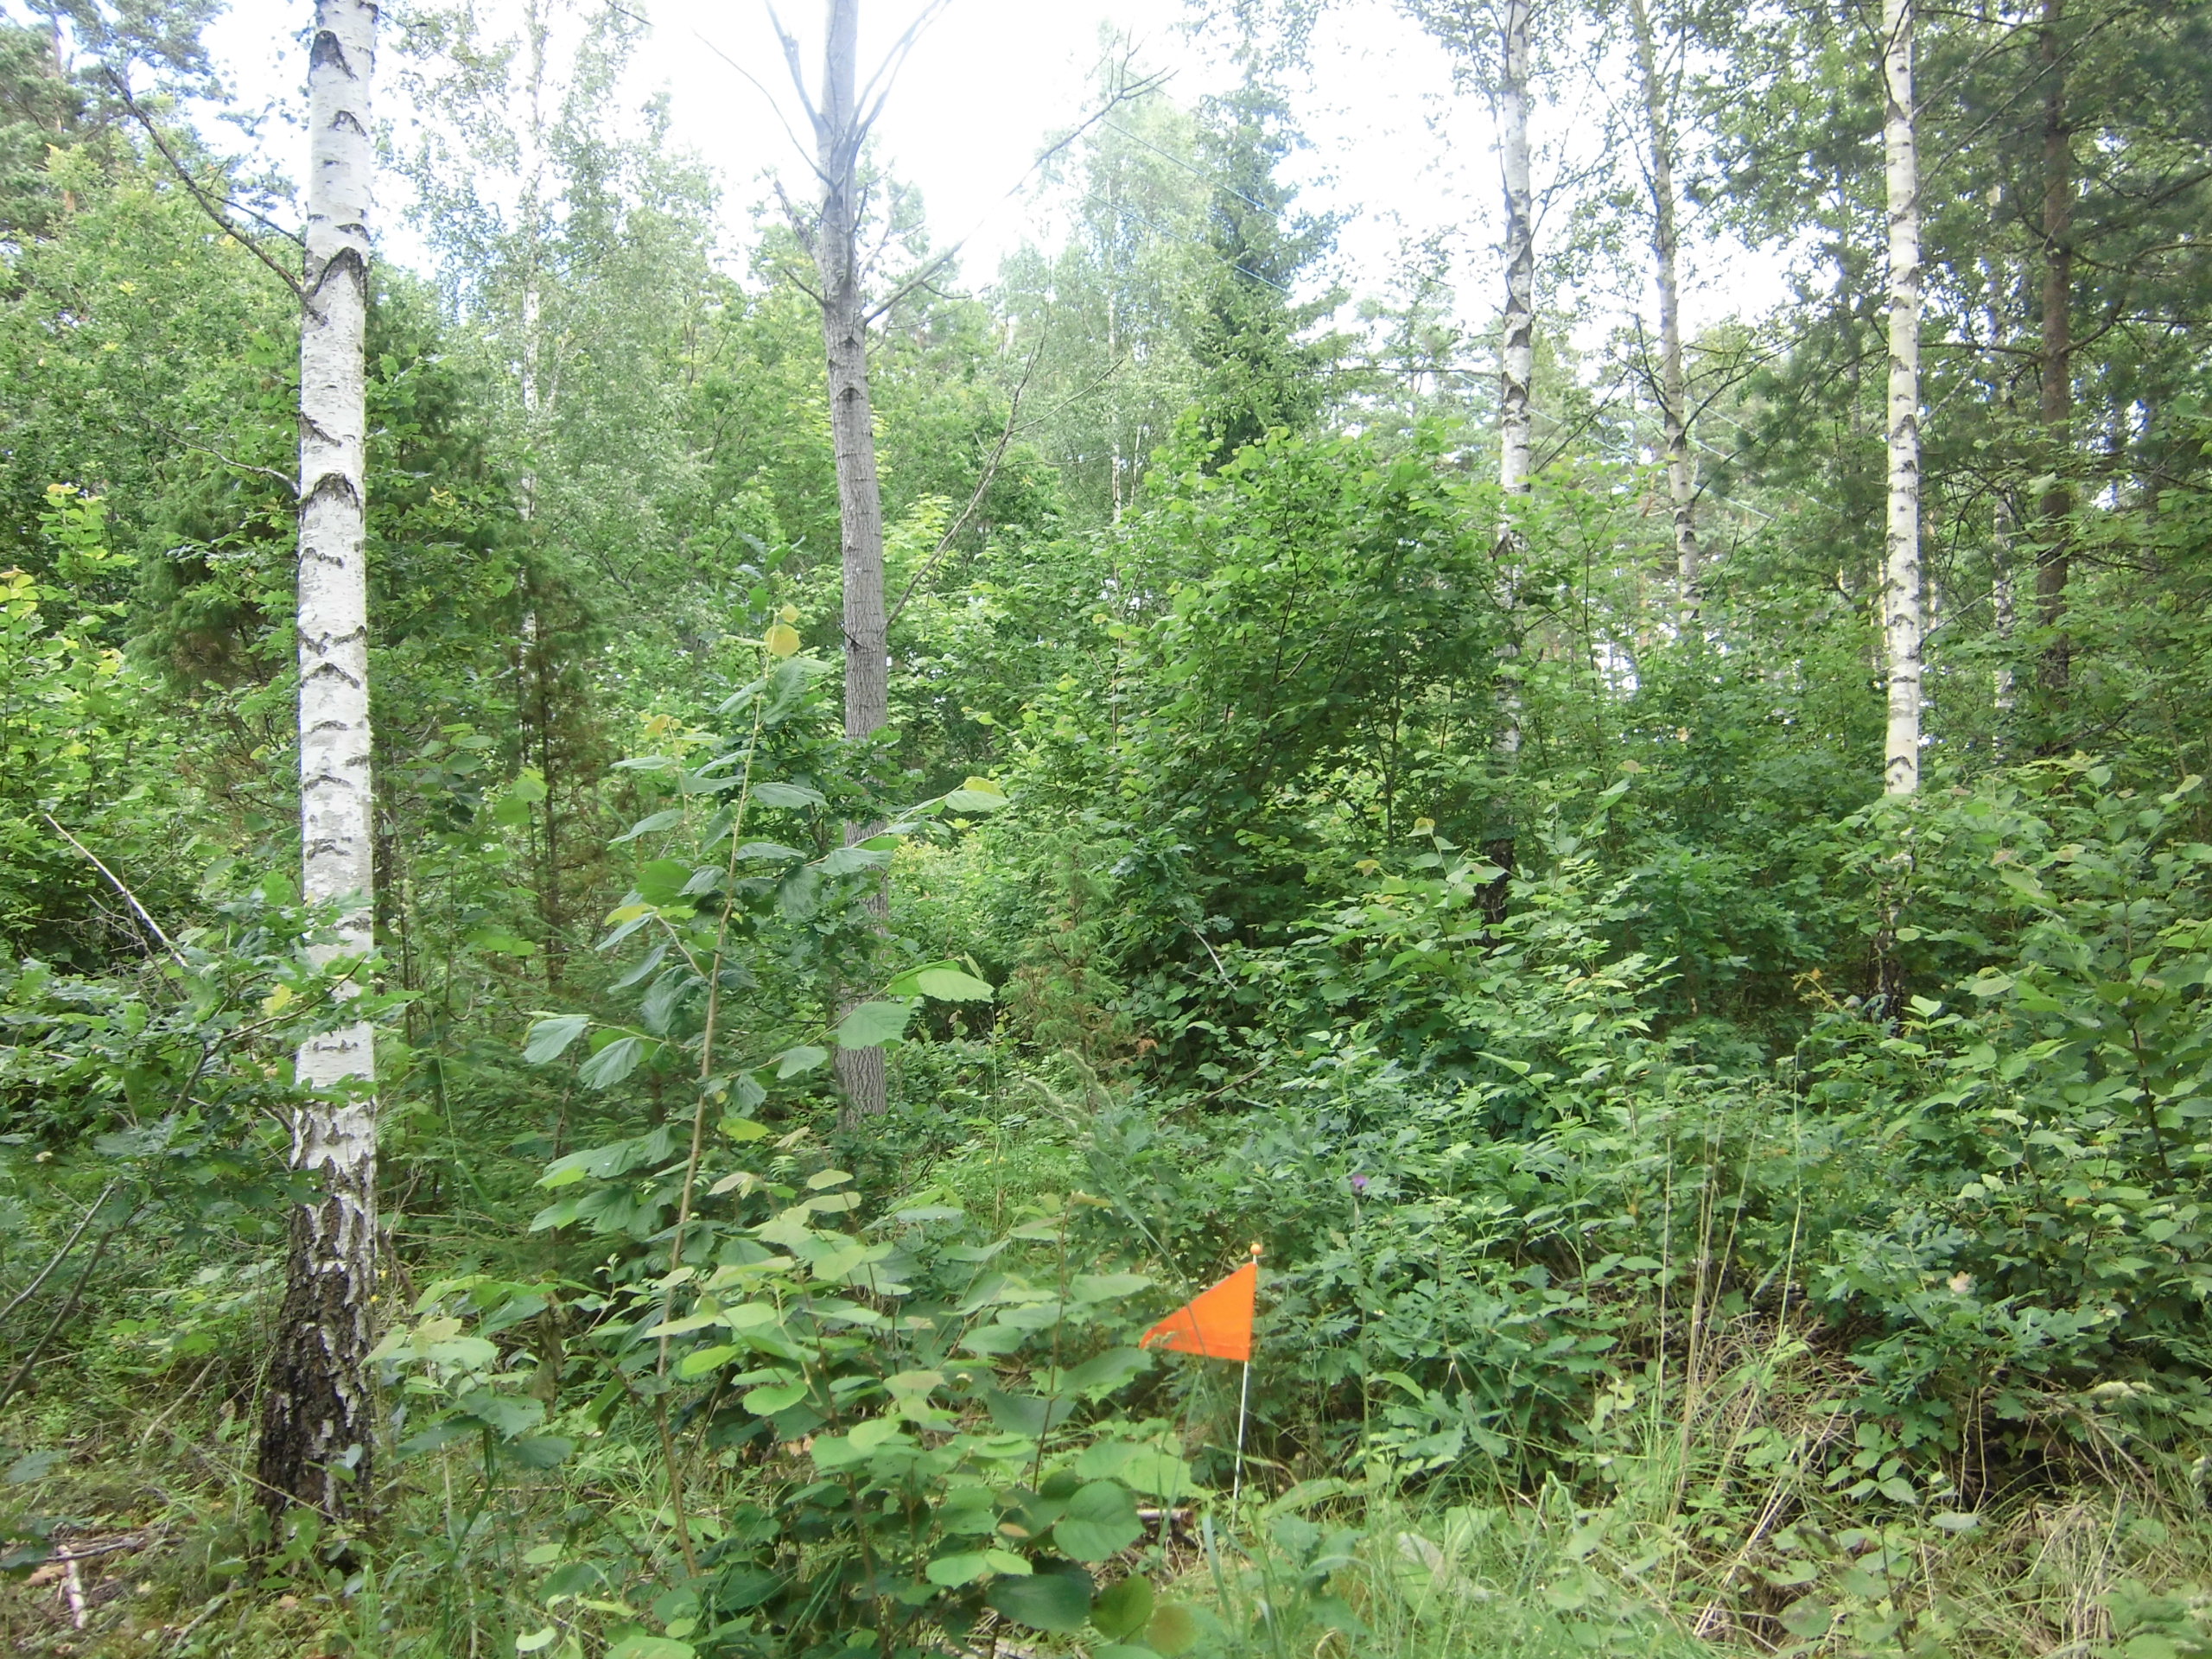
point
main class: Woodland
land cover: Broadleaved woodland
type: hemiboreal forest and nemoral coniferous forest and mixed broadleaved-coniferous forest
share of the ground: 50 - 75 %
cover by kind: broadleaved forest trees 55 %, herbaceous plants 25 %, shrubs 10 %, coniferous forest trees 5 %, lichens and mosses 5 %
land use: Forestry
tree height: > 5 m
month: July
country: SE
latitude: 57.2202
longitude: 15.5785
